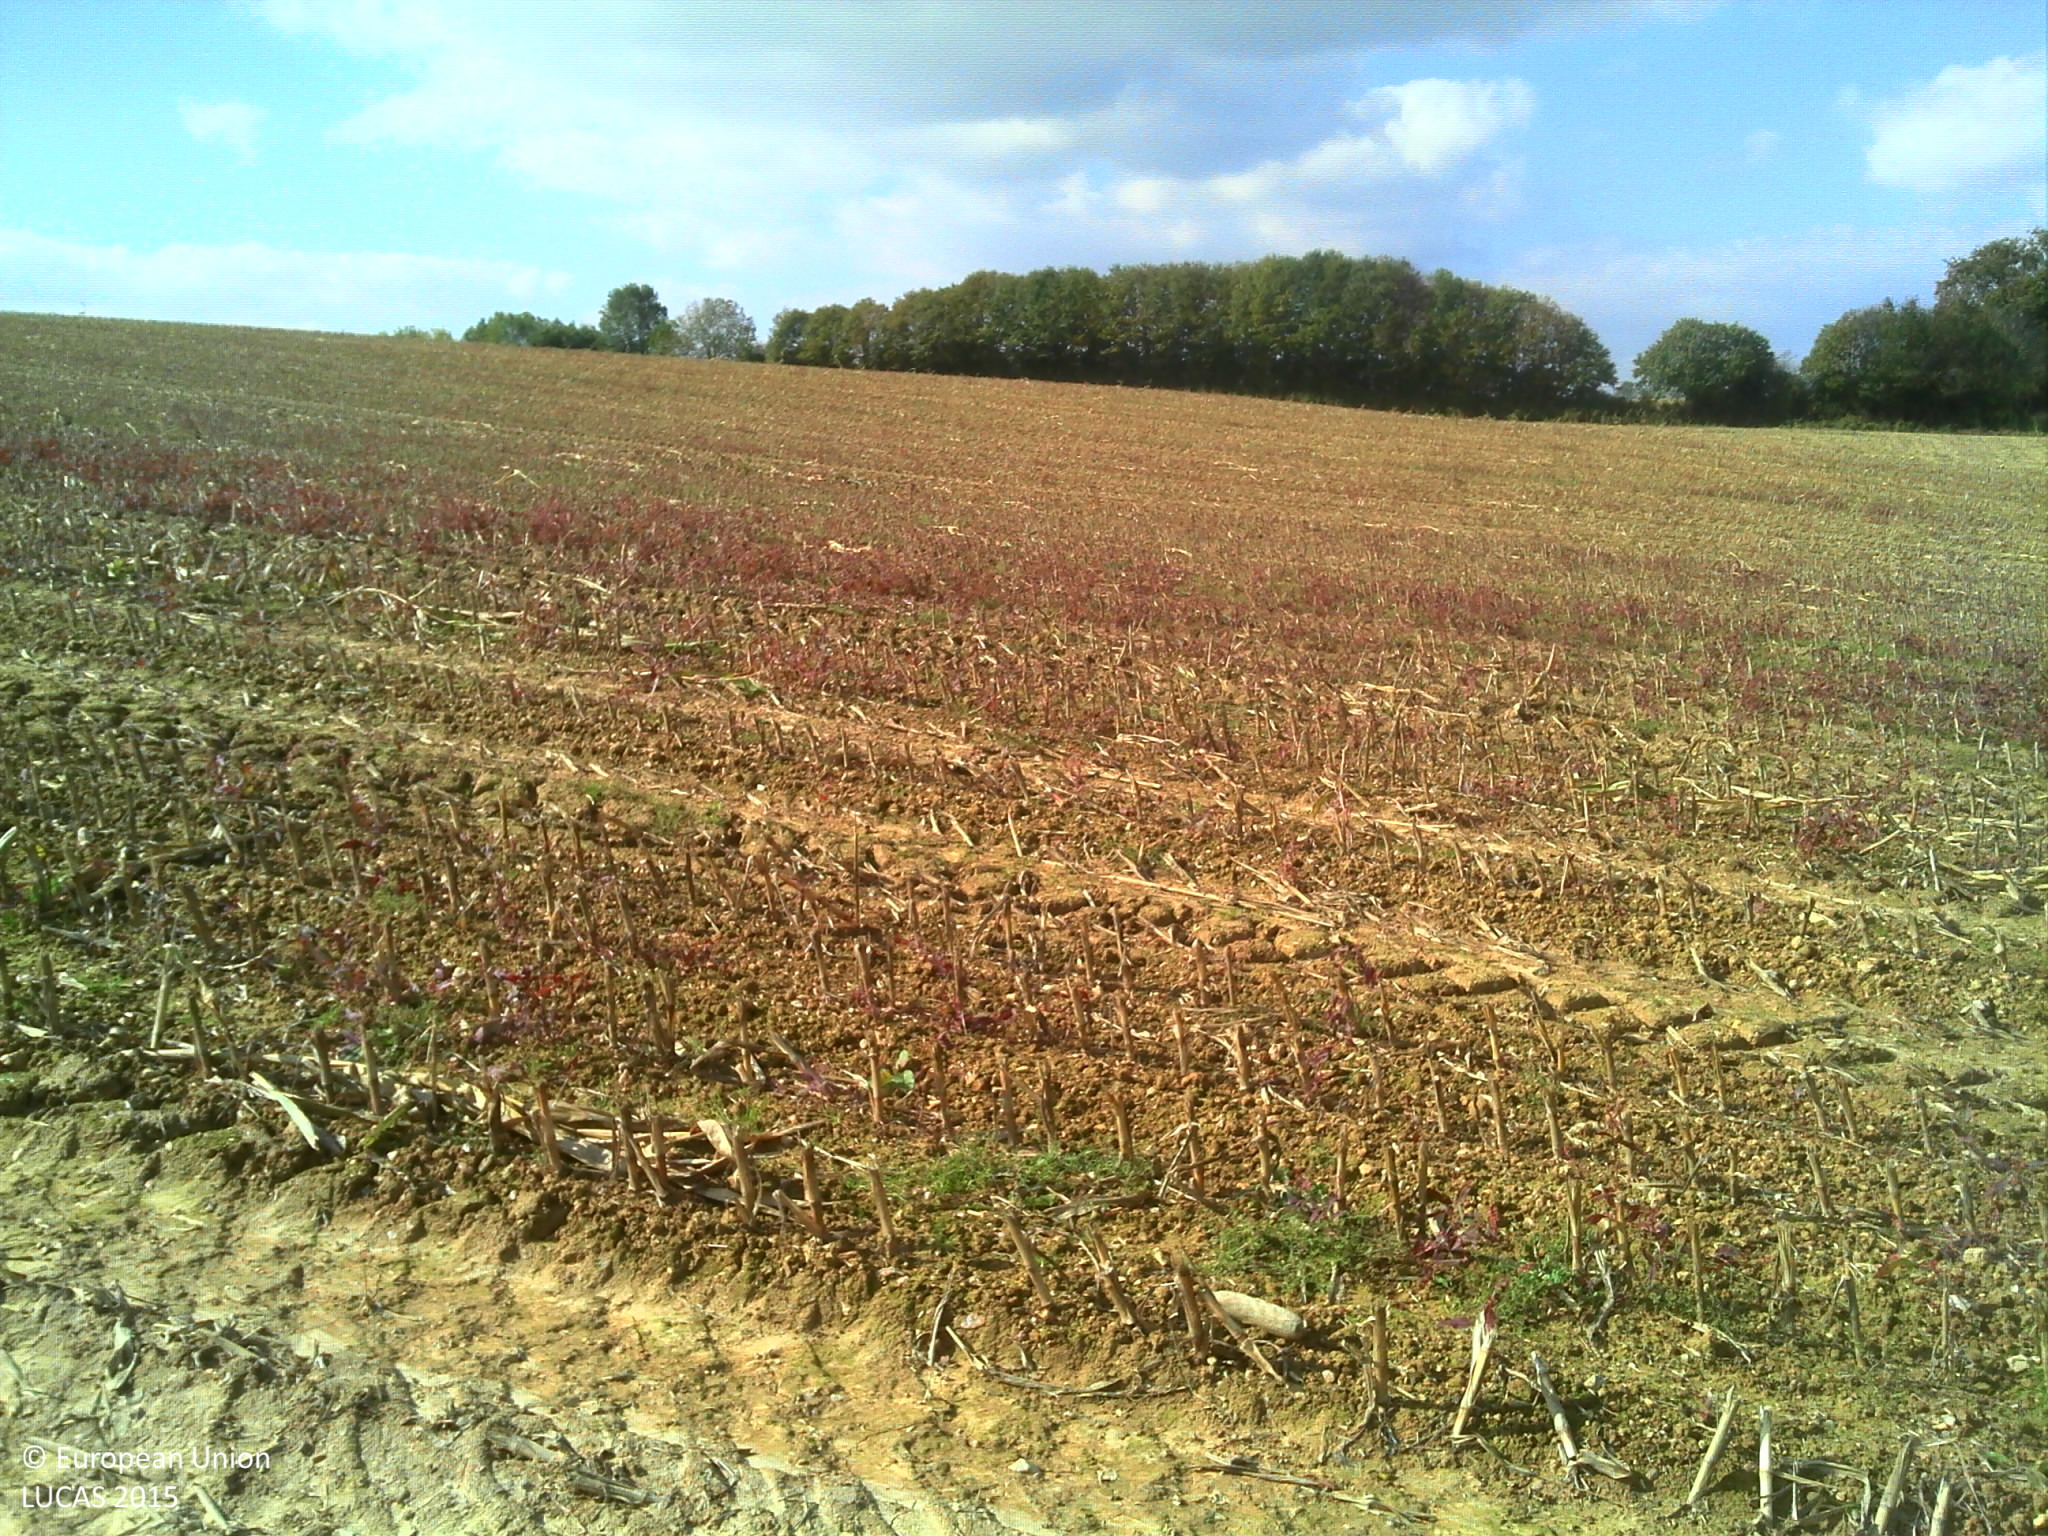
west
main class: Cropland
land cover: Maize
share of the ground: < 10 %
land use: Agriculture (excluding fallow land and kitchen gardens)
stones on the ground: < 10 %
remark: Harvested field
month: October
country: FR
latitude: 46.5789
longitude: -0.8483
